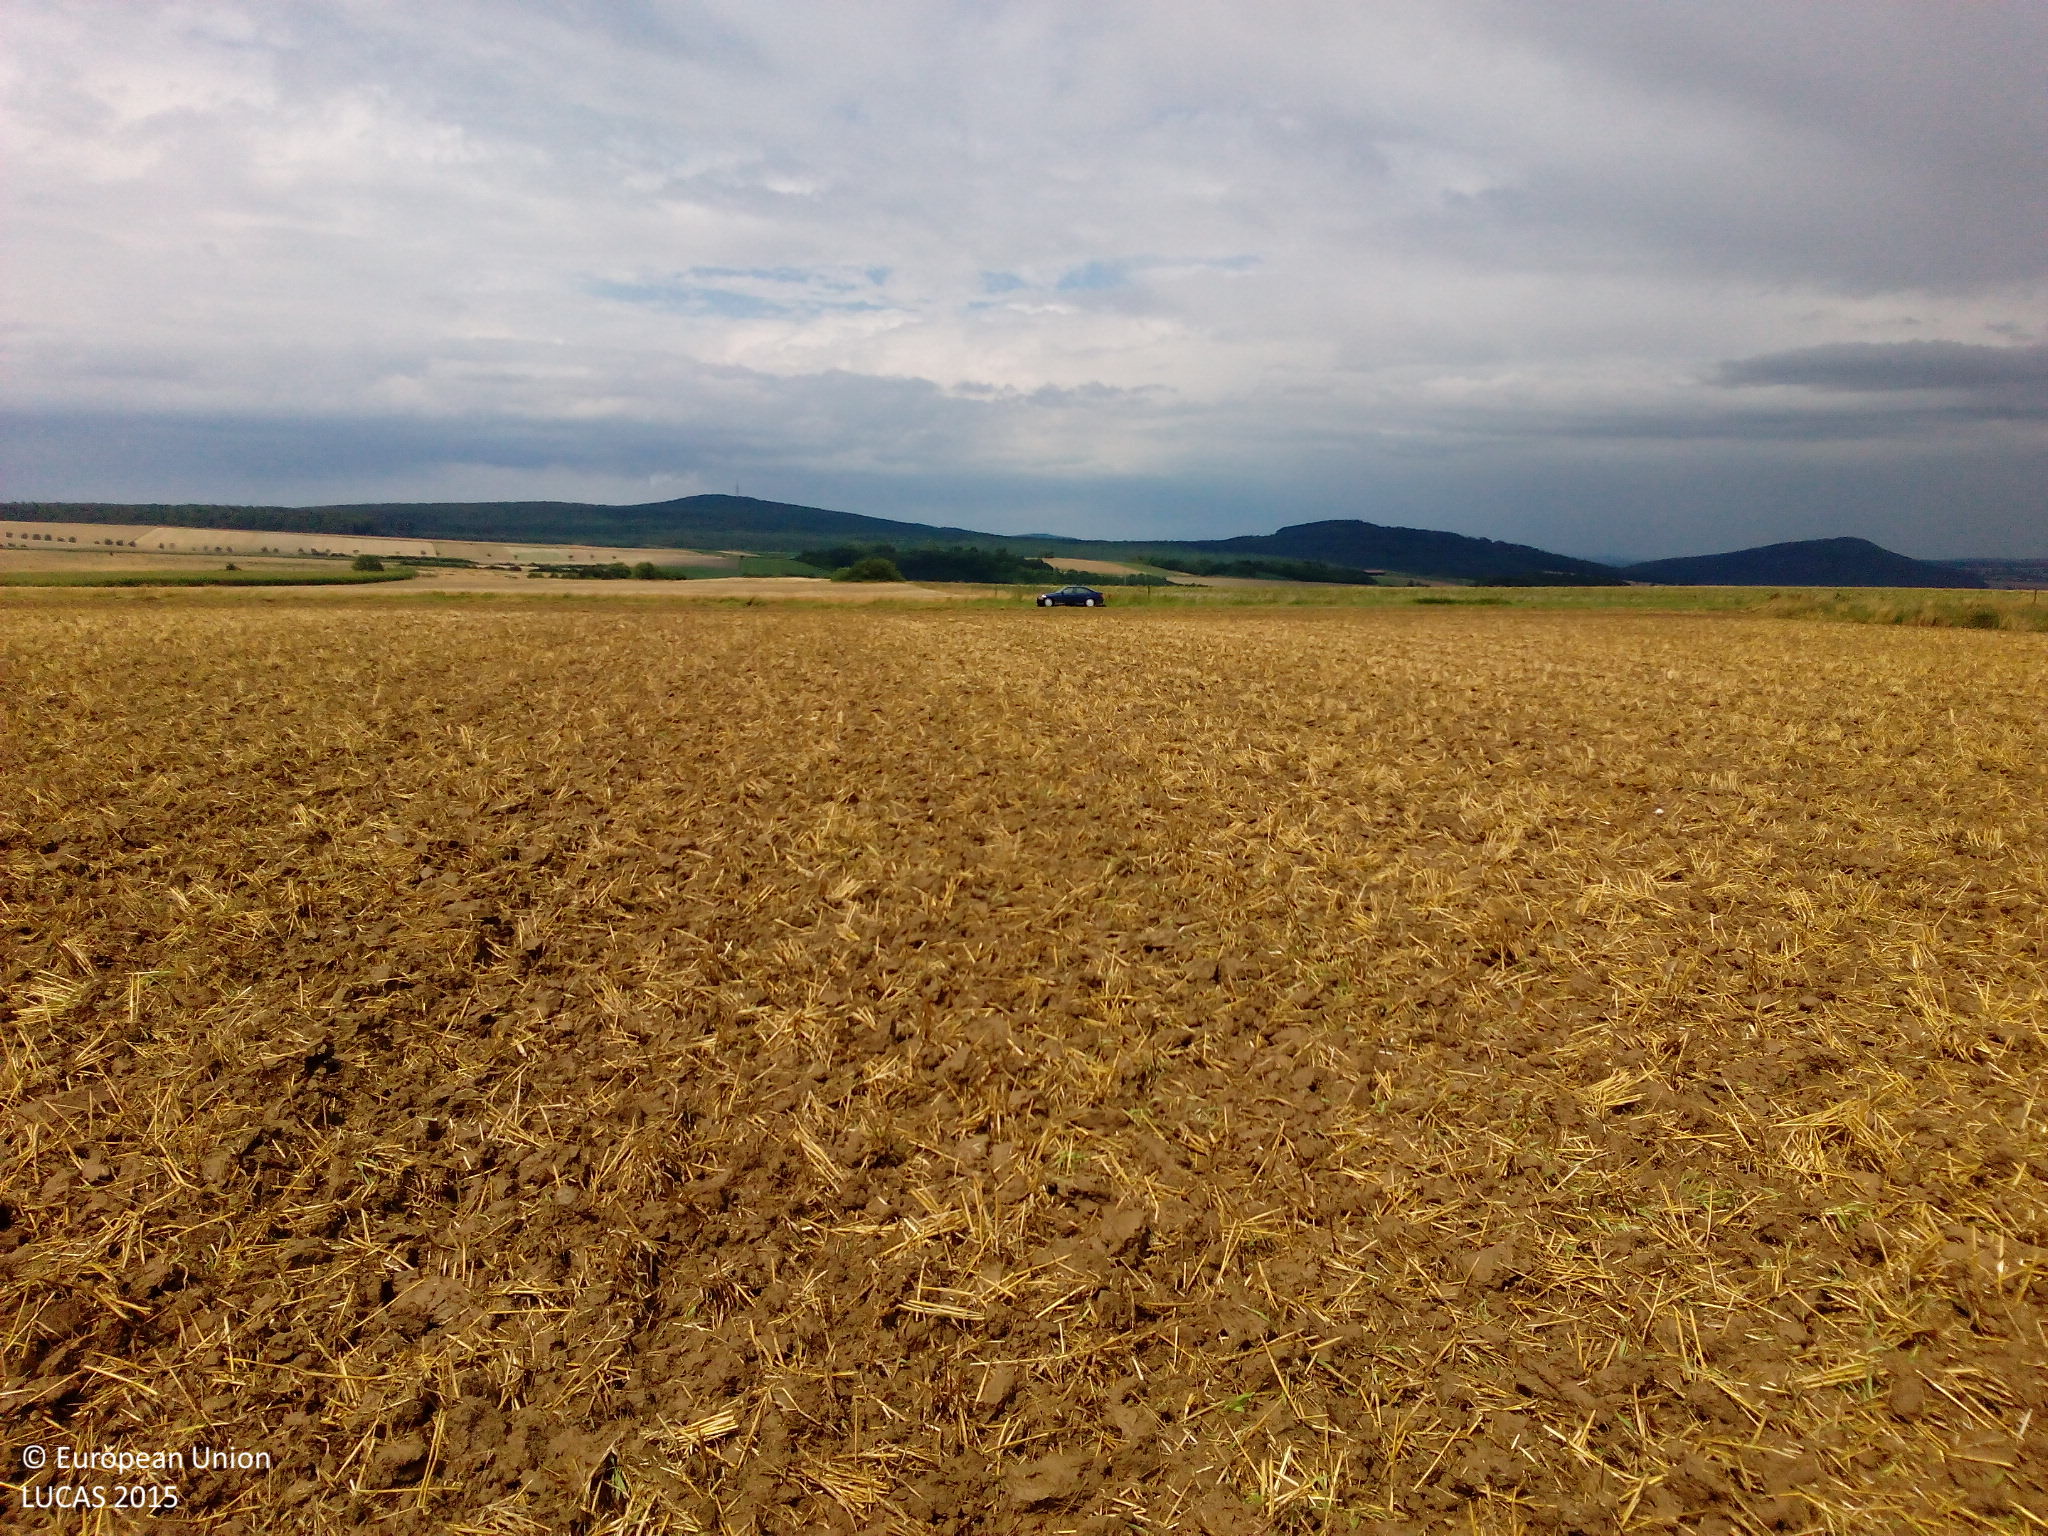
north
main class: Cropland
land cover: Barley
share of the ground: < 10 %
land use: Agriculture (excluding fallow land and kitchen gardens)
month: July
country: DE
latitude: 51.4769
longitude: 9.3523
